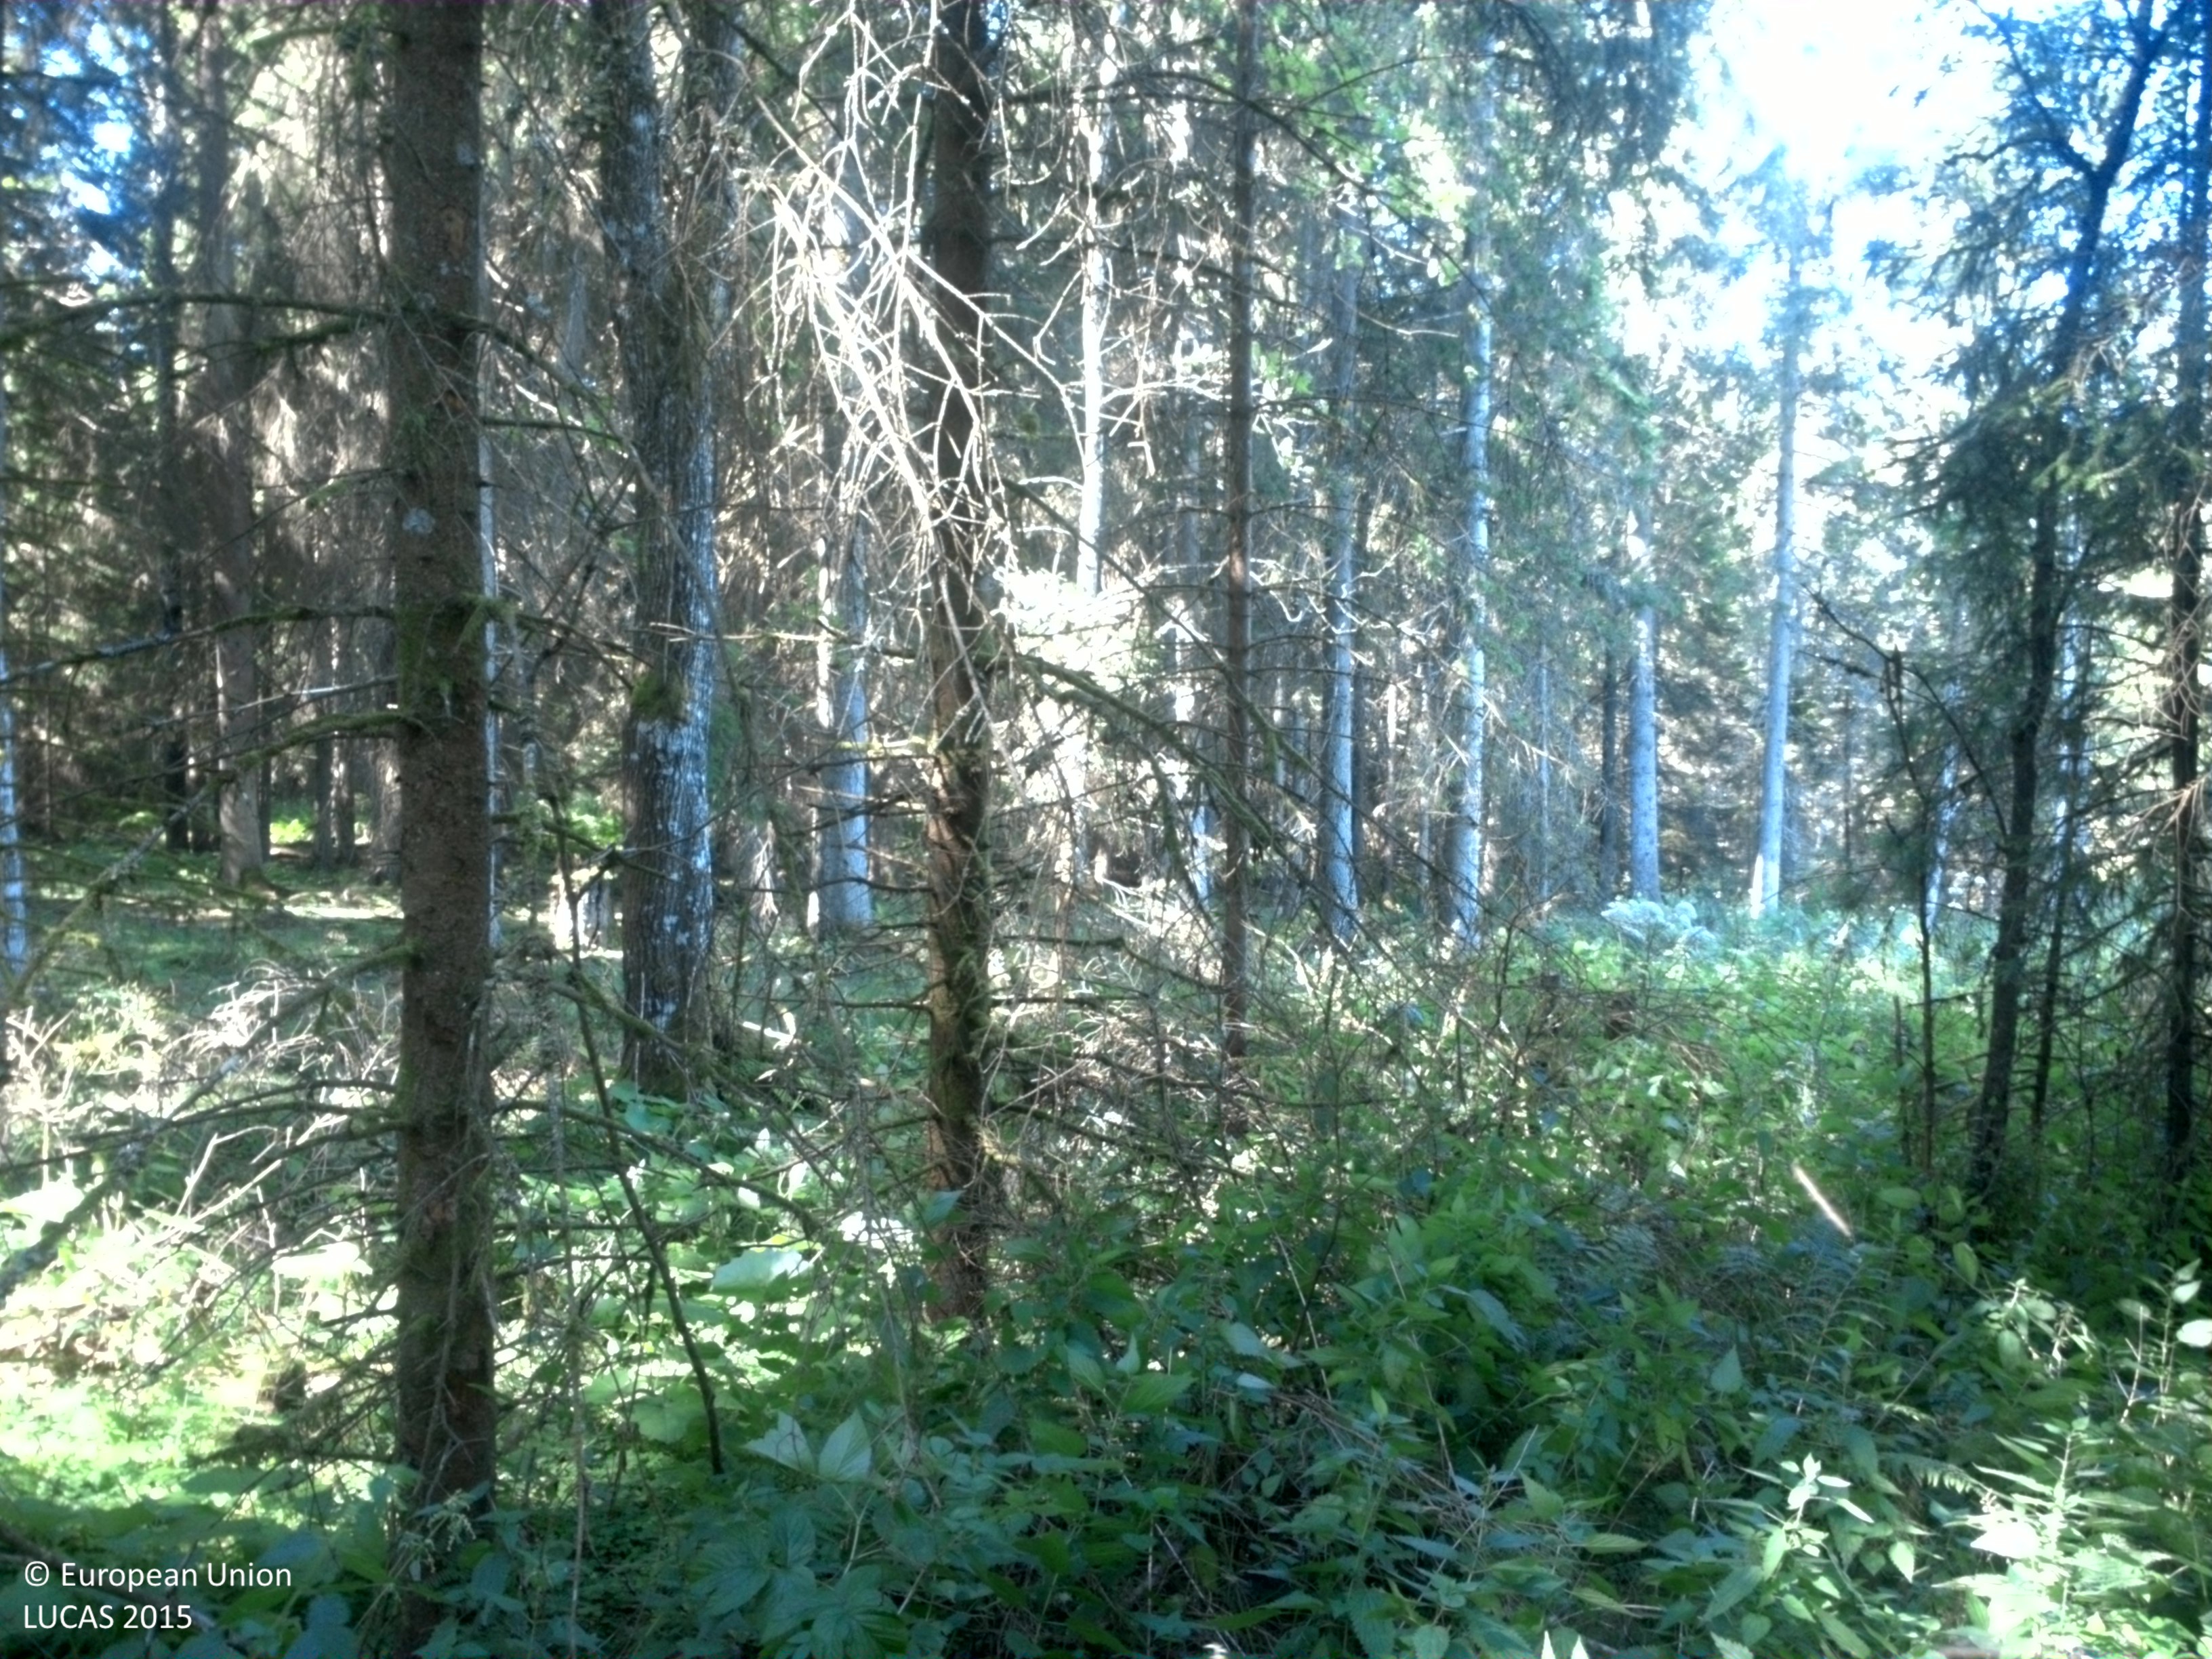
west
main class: Woodland
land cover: Spruce dominated coniferous woodland
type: boreal forest
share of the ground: 50 - 75 %
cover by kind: coniferous forest trees 55 %, herbaceous plants 30 %, lichens and mosses 10 %, broadleaved forest trees 5 %
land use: Forestry
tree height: > 5 m
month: August
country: SE
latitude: 57.9992
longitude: 13.2941
